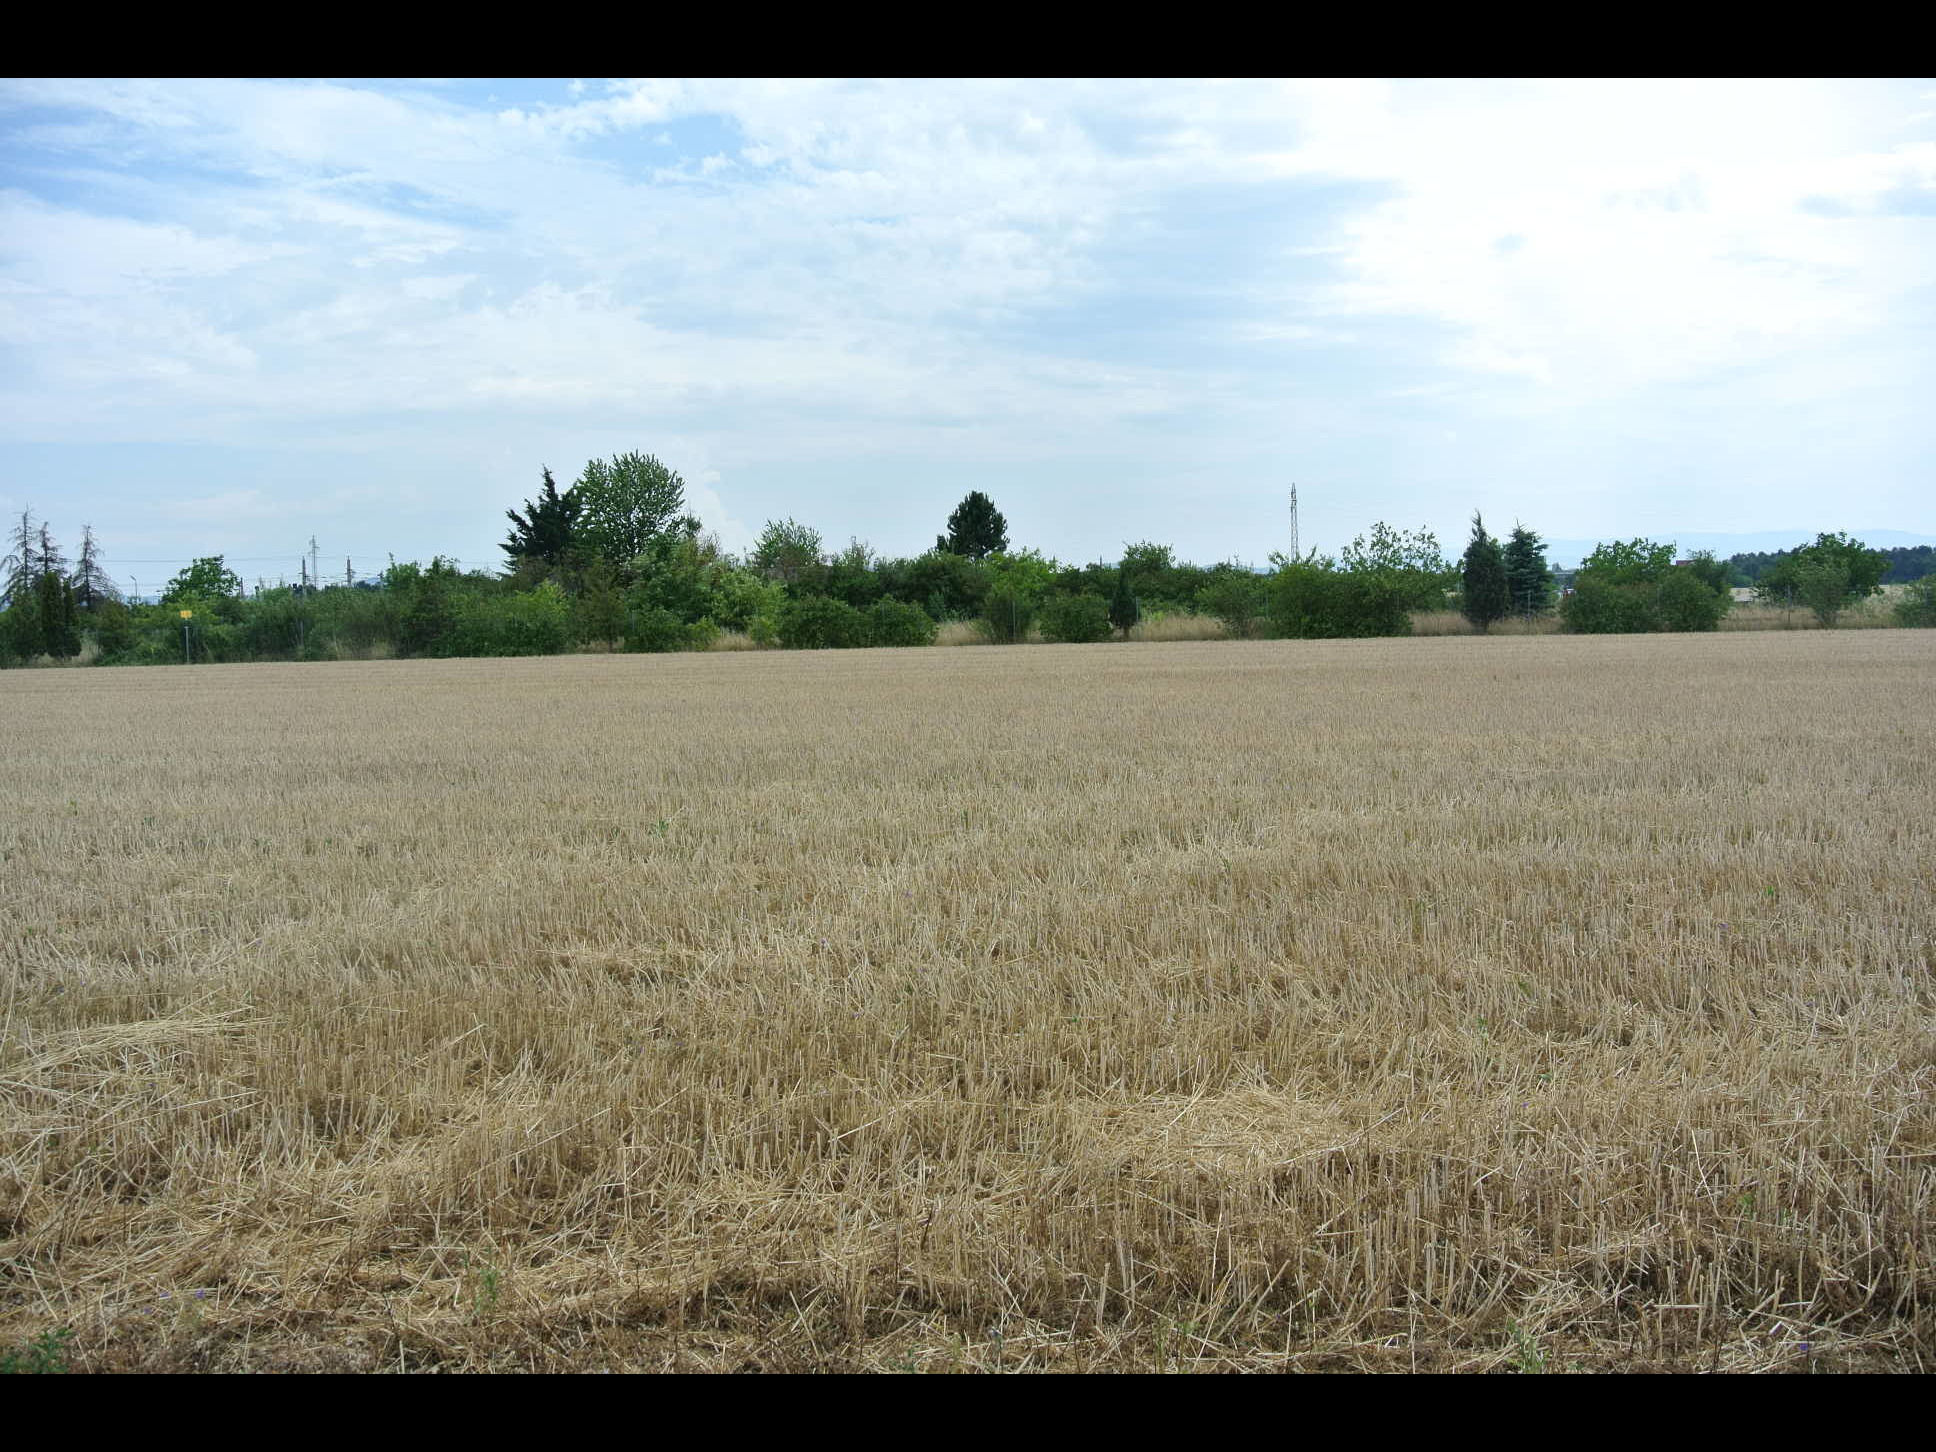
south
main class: Cropland
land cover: Common wheat
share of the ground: > 75 %
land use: Agriculture (excluding fallow land and kitchen gardens)
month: July
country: AT
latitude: 47.7957
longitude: 16.2113
